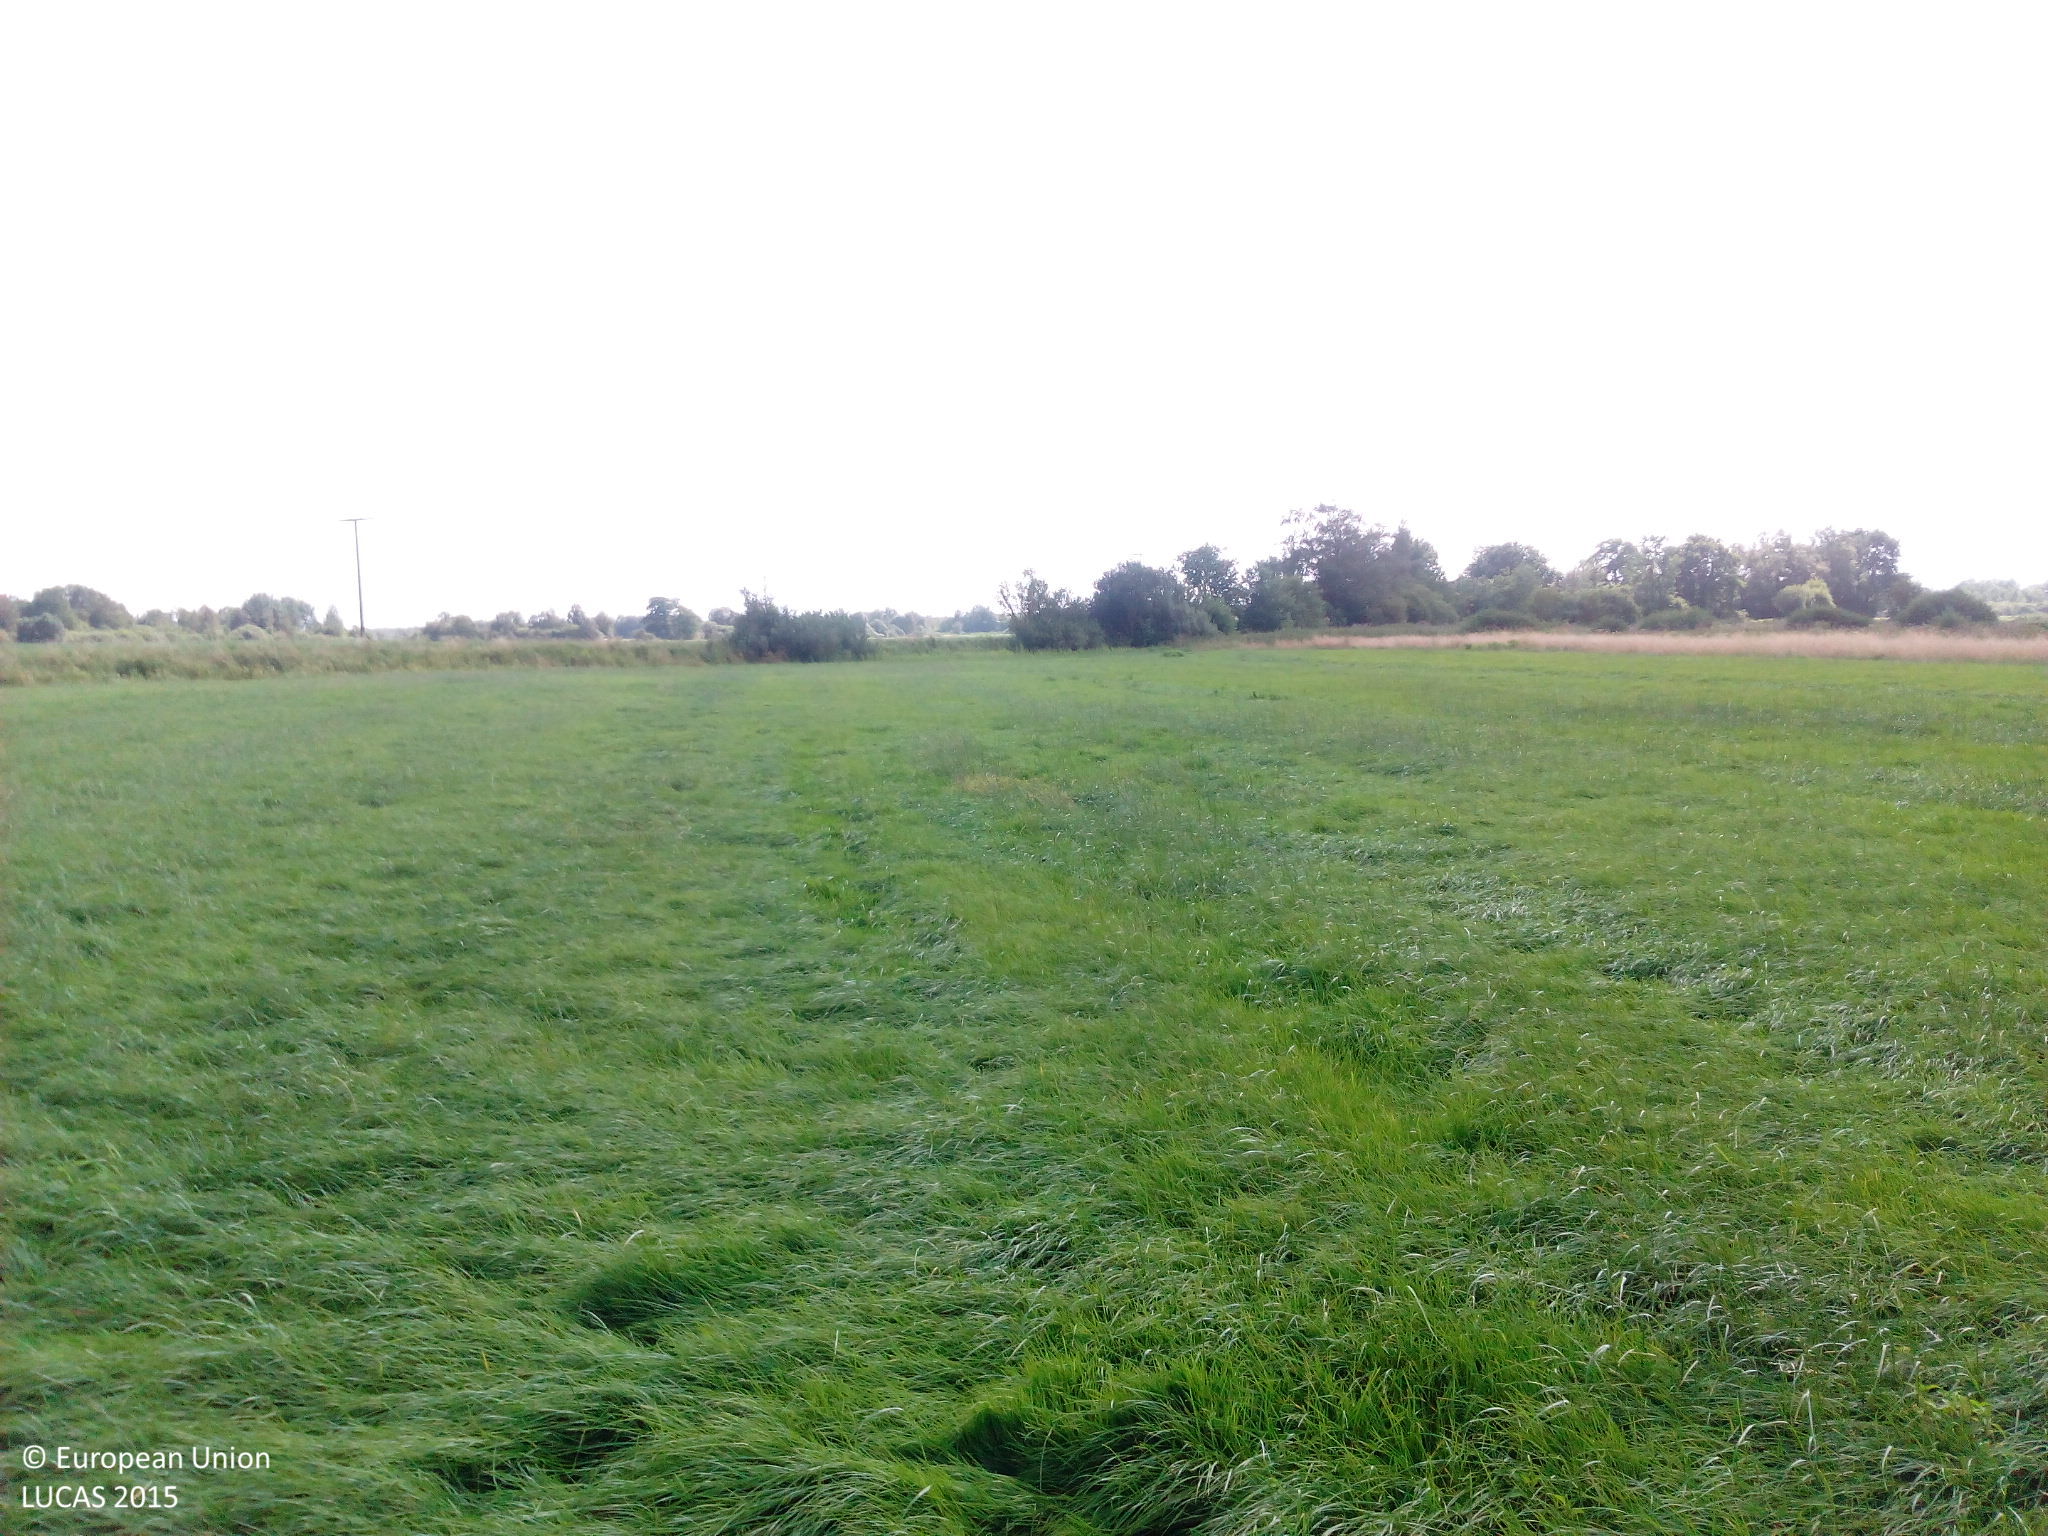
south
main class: Grassland
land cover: Grassland without tree/shrub cover
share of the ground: > 75 %
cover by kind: herbaceous plants 100 %
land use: Agriculture (excluding fallow land and kitchen gardens)
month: August
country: DE
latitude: 54.0110
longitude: 9.3137
